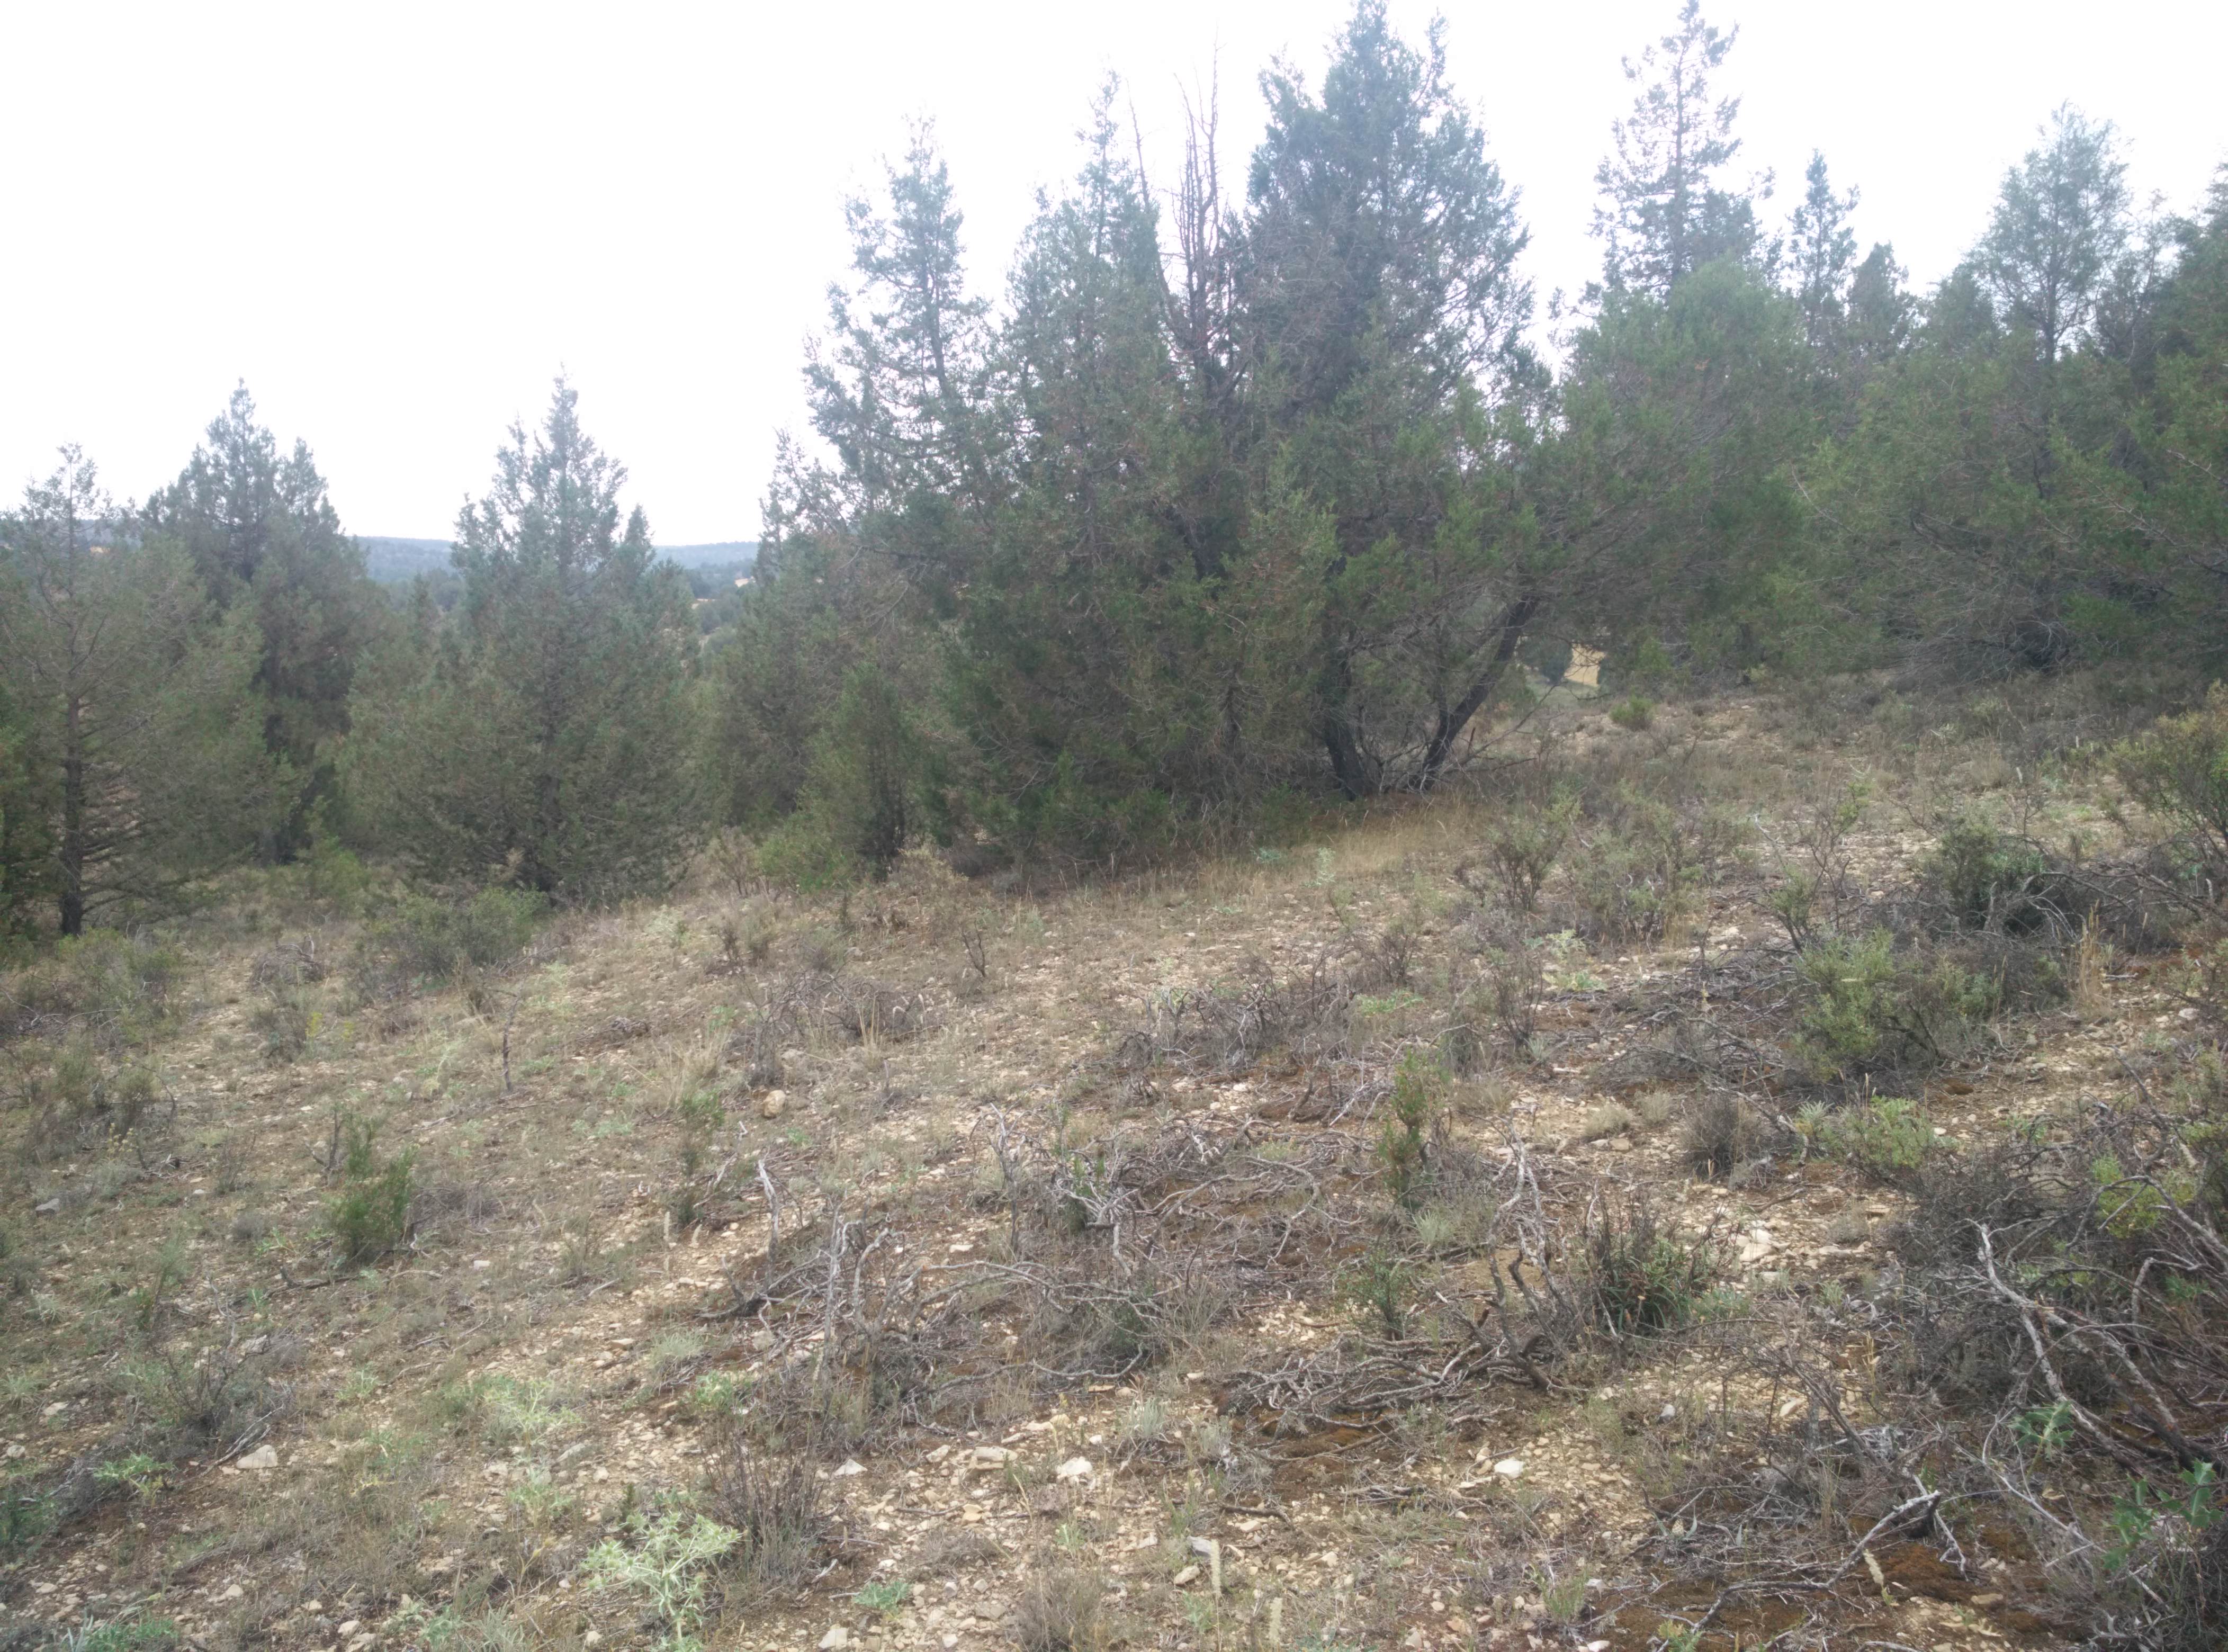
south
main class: Woodland
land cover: Other coniferous woodland
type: coniferous forest of the mediterranean region
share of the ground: 25 - 50 %
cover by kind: coniferous forest trees 40 %, herbaceous plants 30 %, unconsolidated bare surface 30 %
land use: Semi-natural and natural areas not in use
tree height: > 5 m
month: July
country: ES
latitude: 40.7999
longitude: -2.0538
